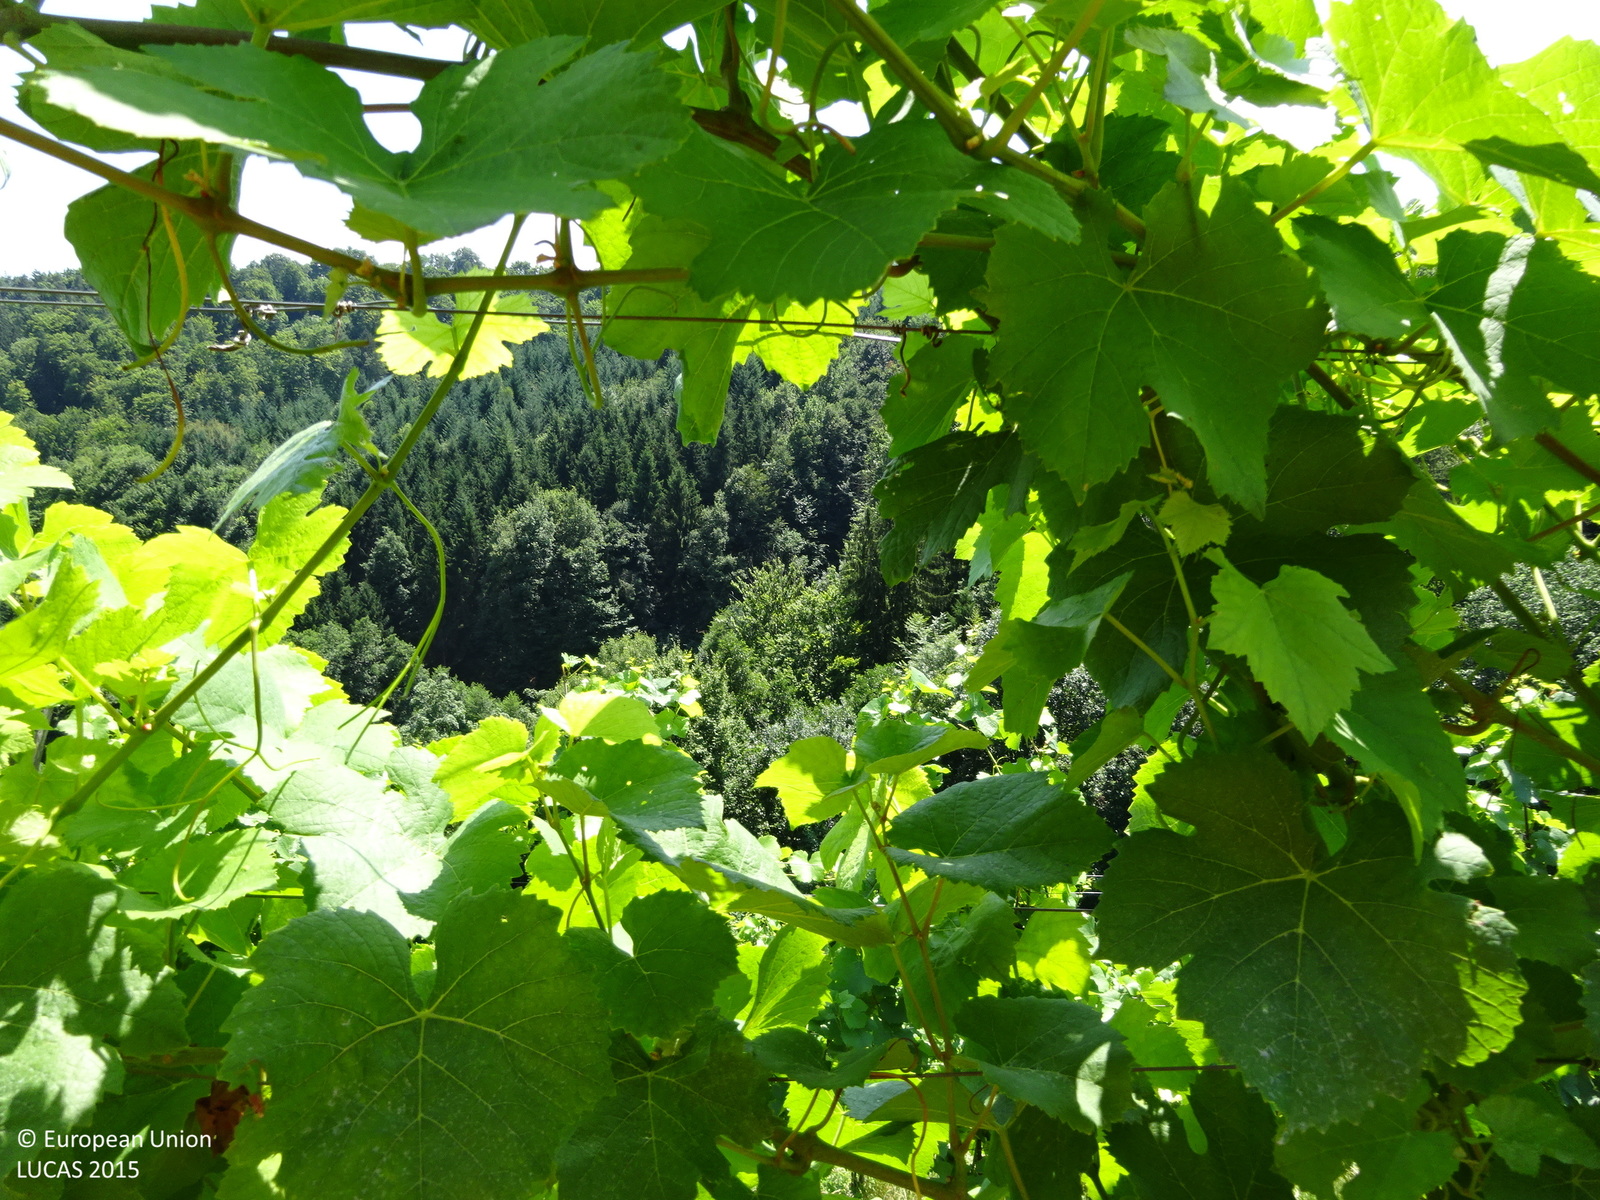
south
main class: Cropland
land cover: Vineyards
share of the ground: 25 - 50 %
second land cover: Grassland without tree/shrub cover
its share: 50 - 75 %
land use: Agriculture (excluding fallow land and kitchen gardens)
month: July
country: AT
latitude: 46.7892
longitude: 15.4619
